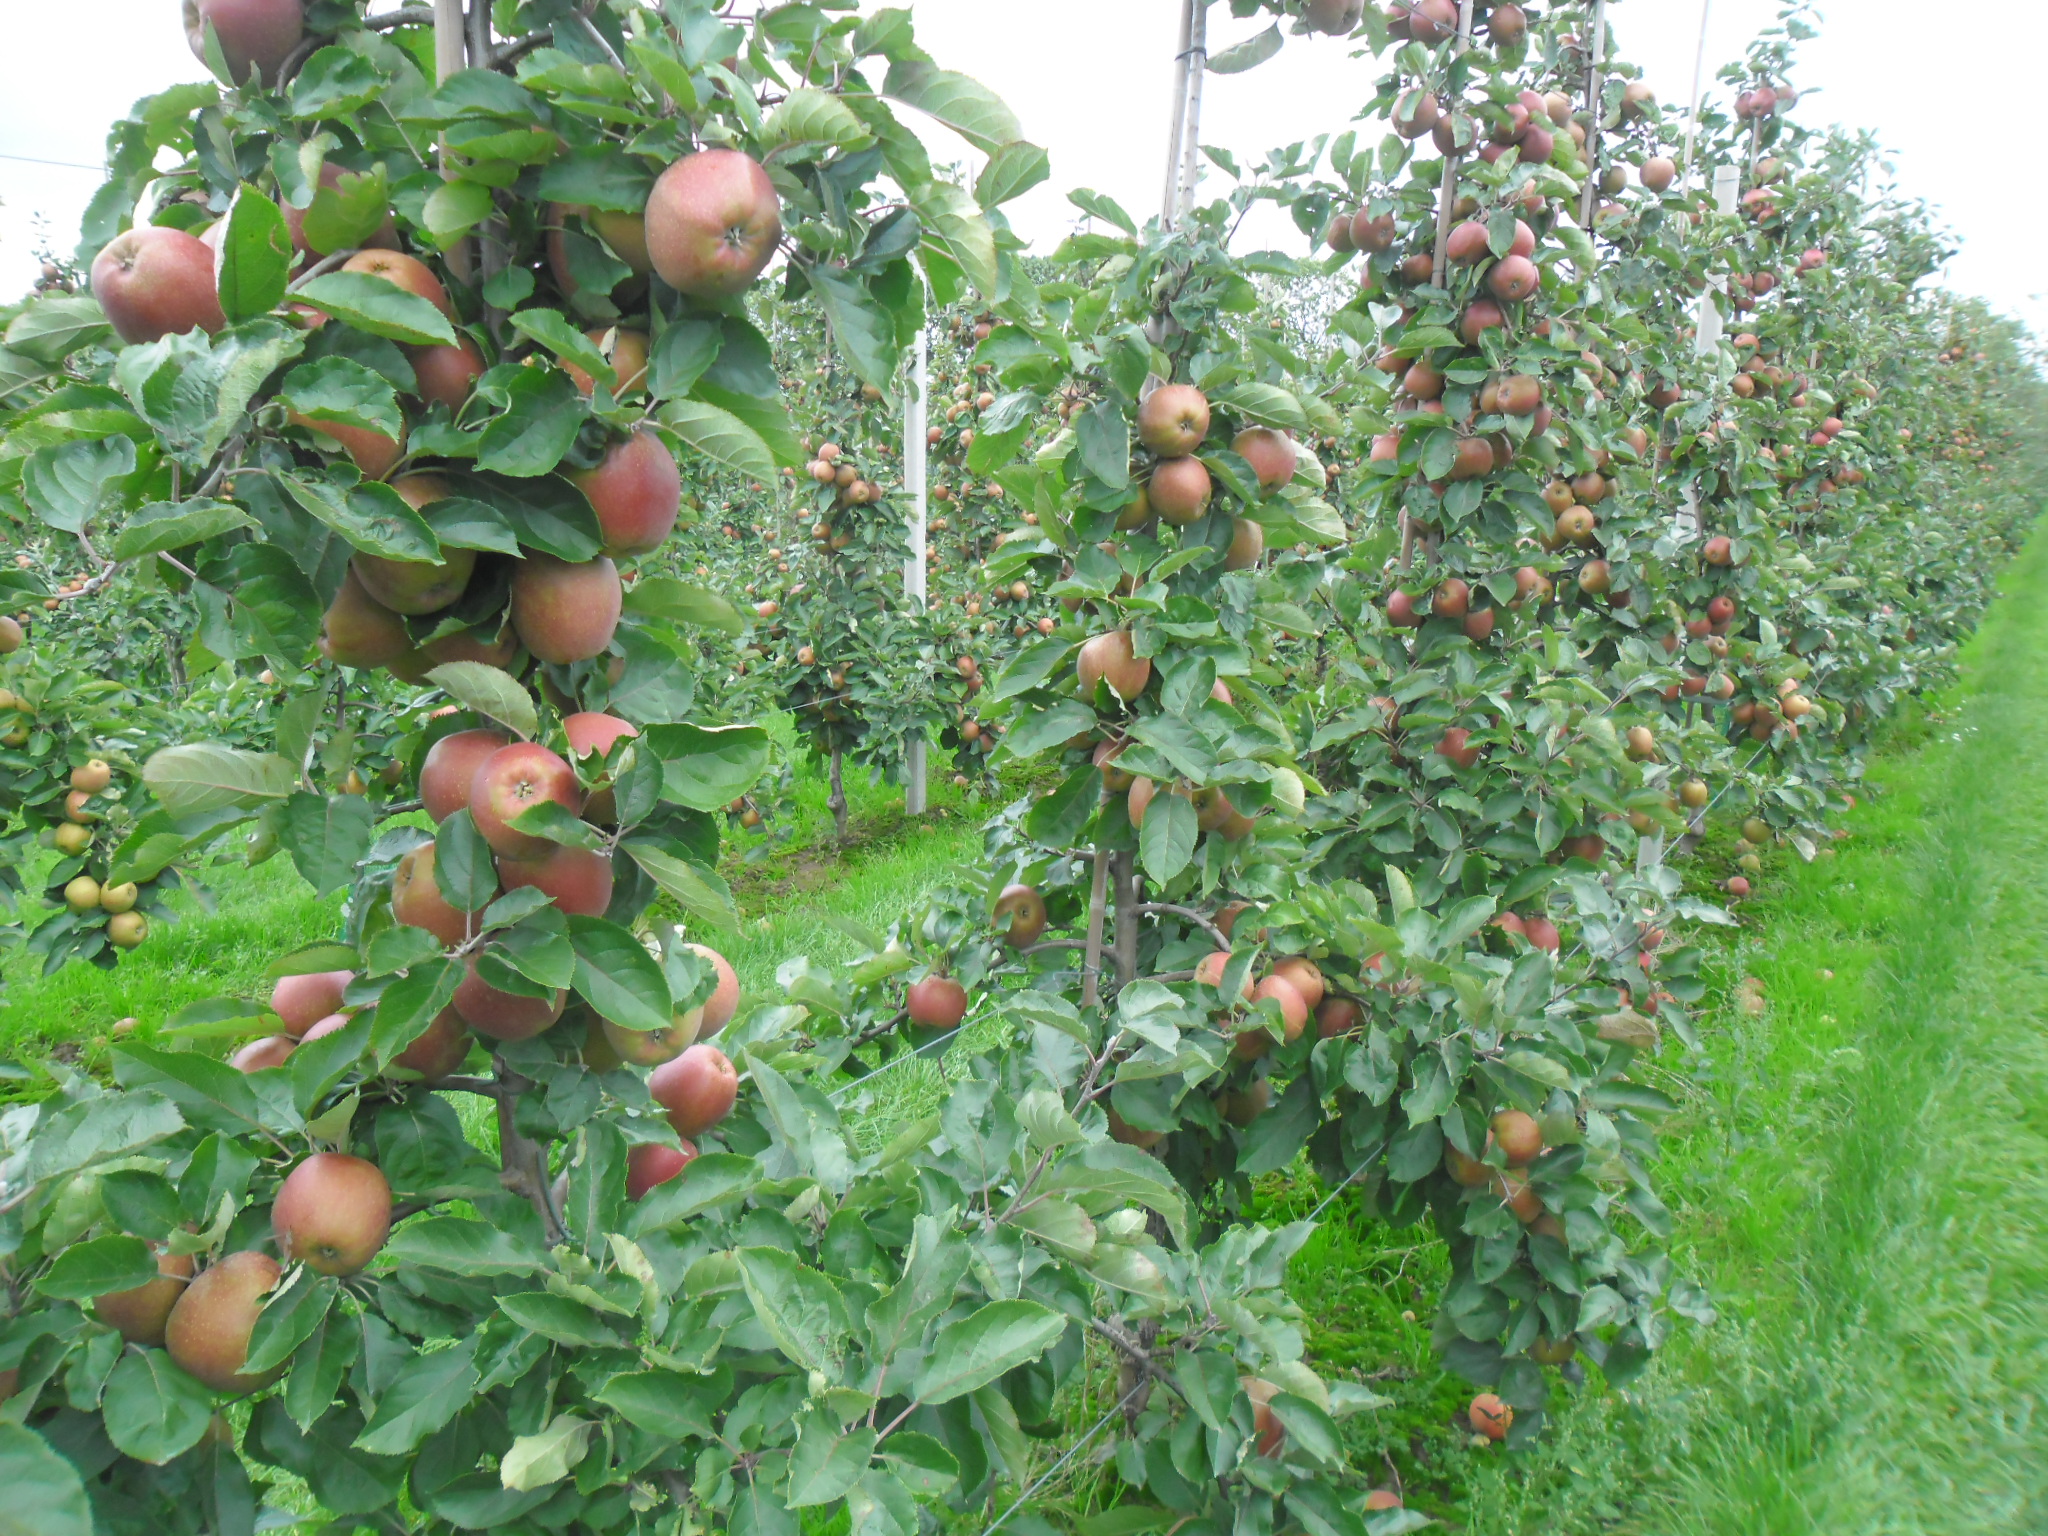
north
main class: Cropland
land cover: Apple fruit
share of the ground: 50 - 75 %
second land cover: Grassland without tree/shrub cover
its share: 25 - 50 %
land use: Agriculture (excluding fallow land and kitchen gardens)
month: September
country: NL
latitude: 51.9682
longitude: 5.5006
